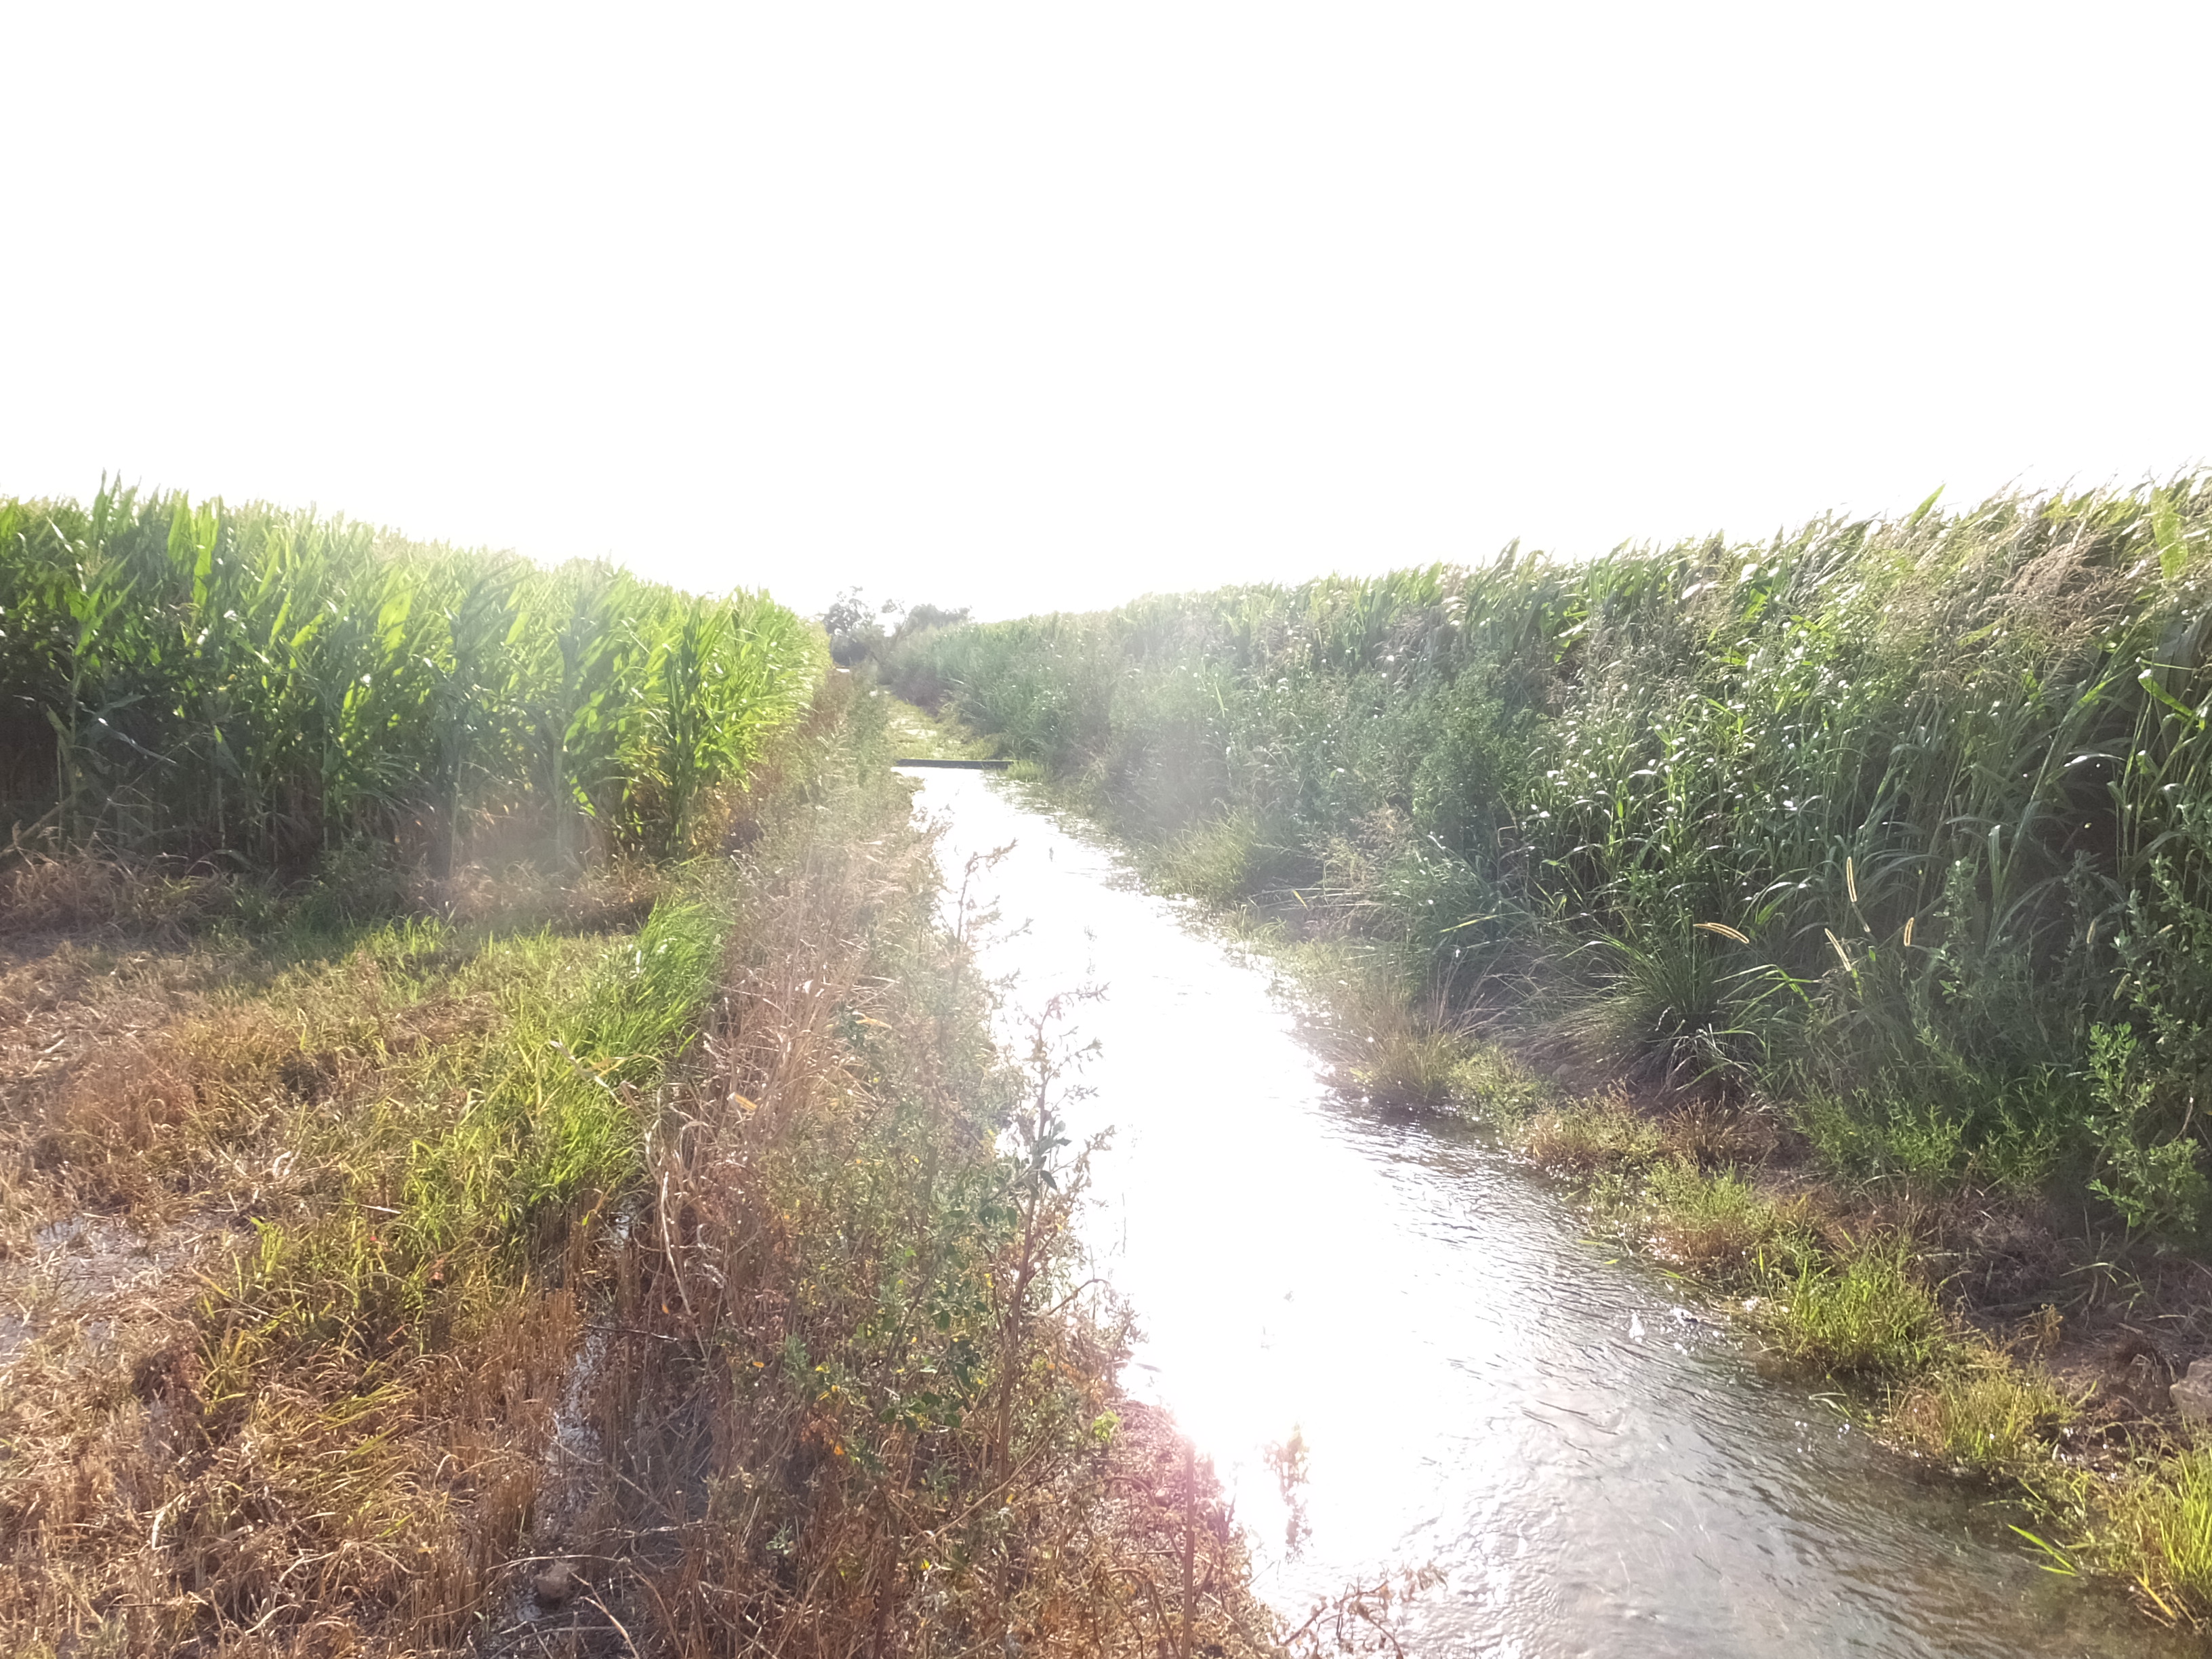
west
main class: Cropland
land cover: Common wheat
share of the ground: < 10 %
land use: Agriculture (excluding fallow land and kitchen gardens)
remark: Harvested field
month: August
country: ES
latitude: 41.6307
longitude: 0.3714
